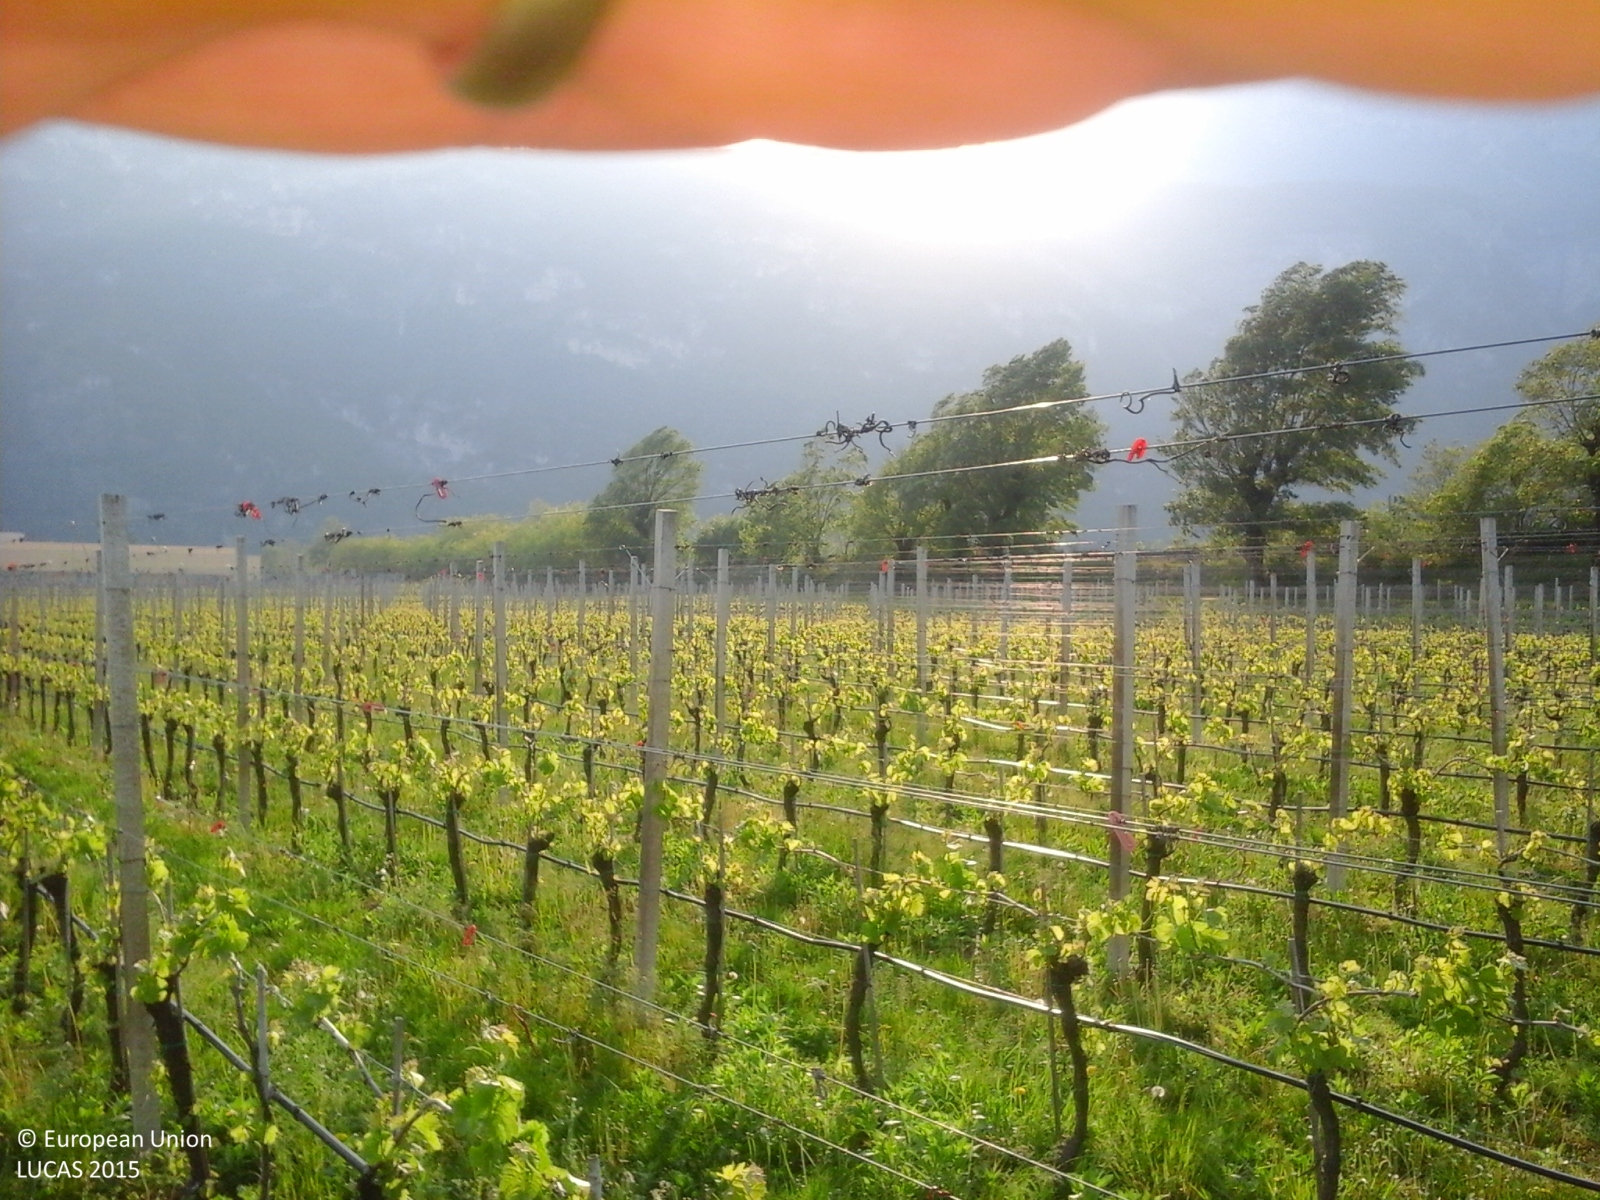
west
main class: Cropland
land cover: Vineyards
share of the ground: < 10 %
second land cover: Grassland without tree/shrub cover
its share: > 75 %
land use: Agriculture (excluding fallow land and kitchen gardens)
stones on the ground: < 10 %
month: April
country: IT
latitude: 46.1294
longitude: 11.0986
